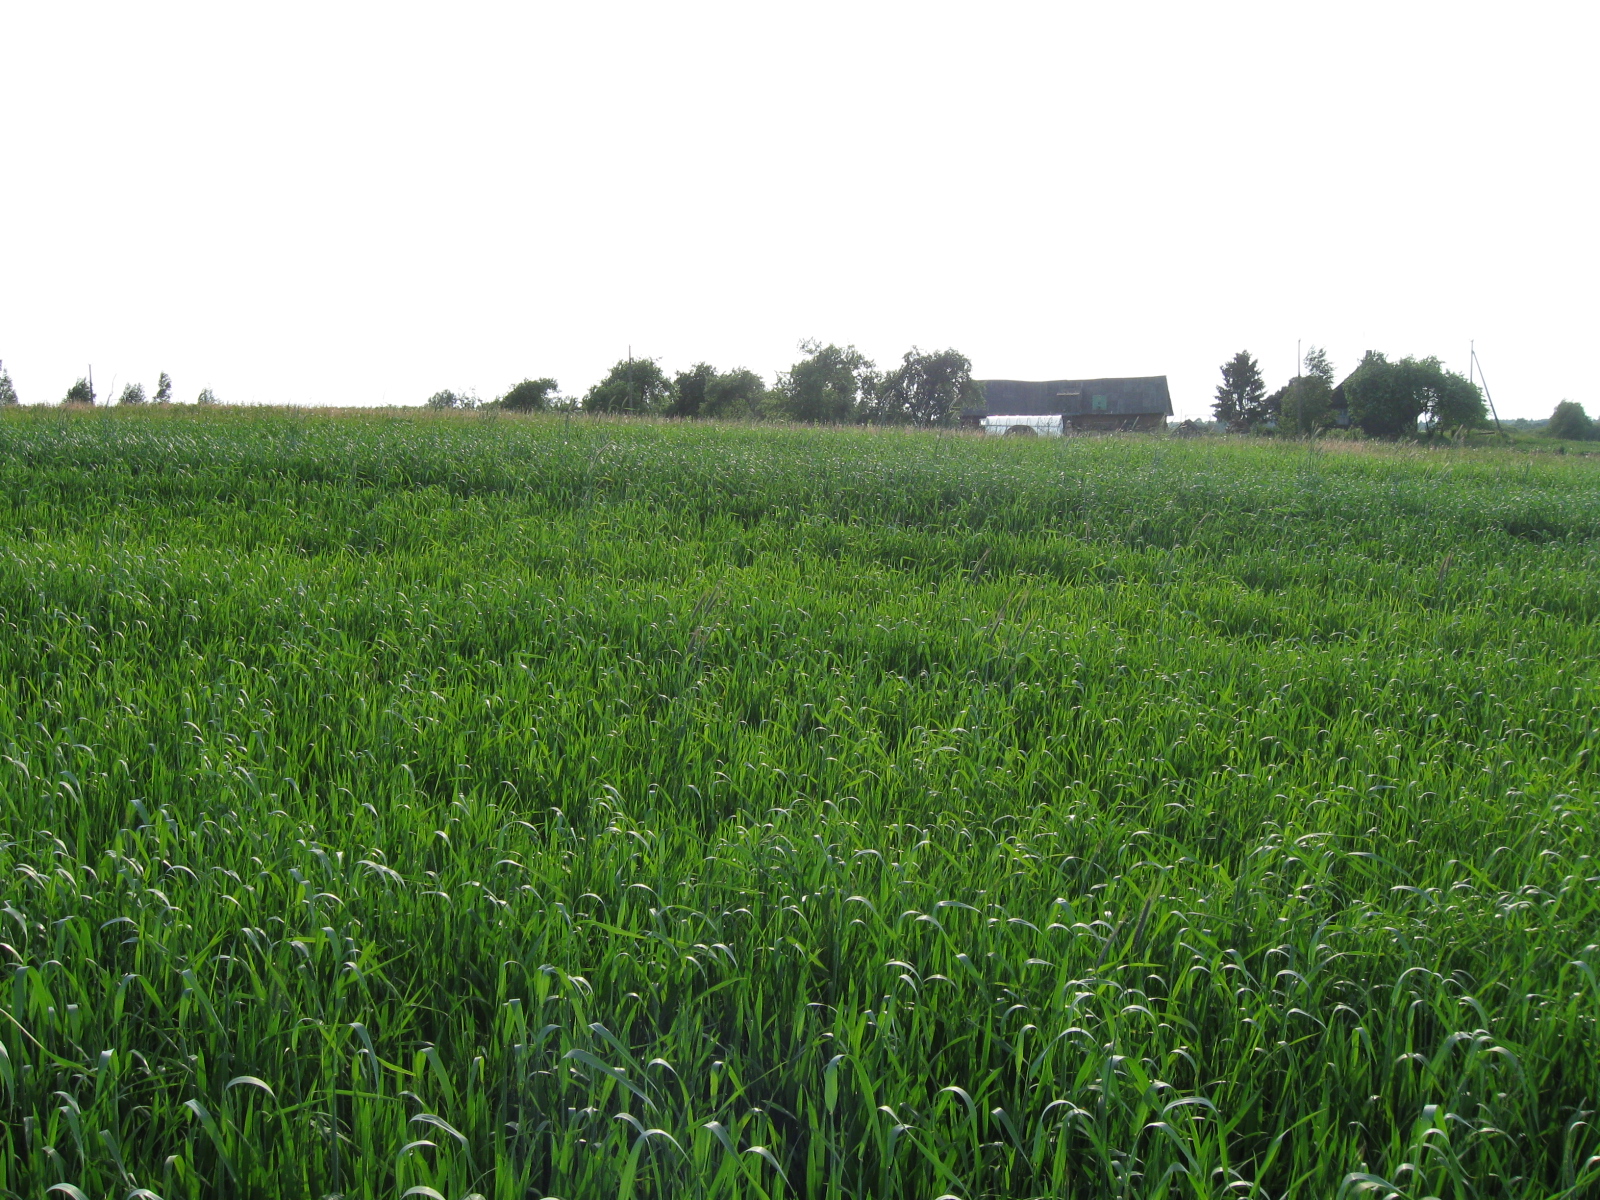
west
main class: Cropland
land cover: Common wheat
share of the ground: > 75 %
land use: Agriculture (excluding fallow land and kitchen gardens)
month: June
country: LT
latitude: 54.2323
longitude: 23.6314
